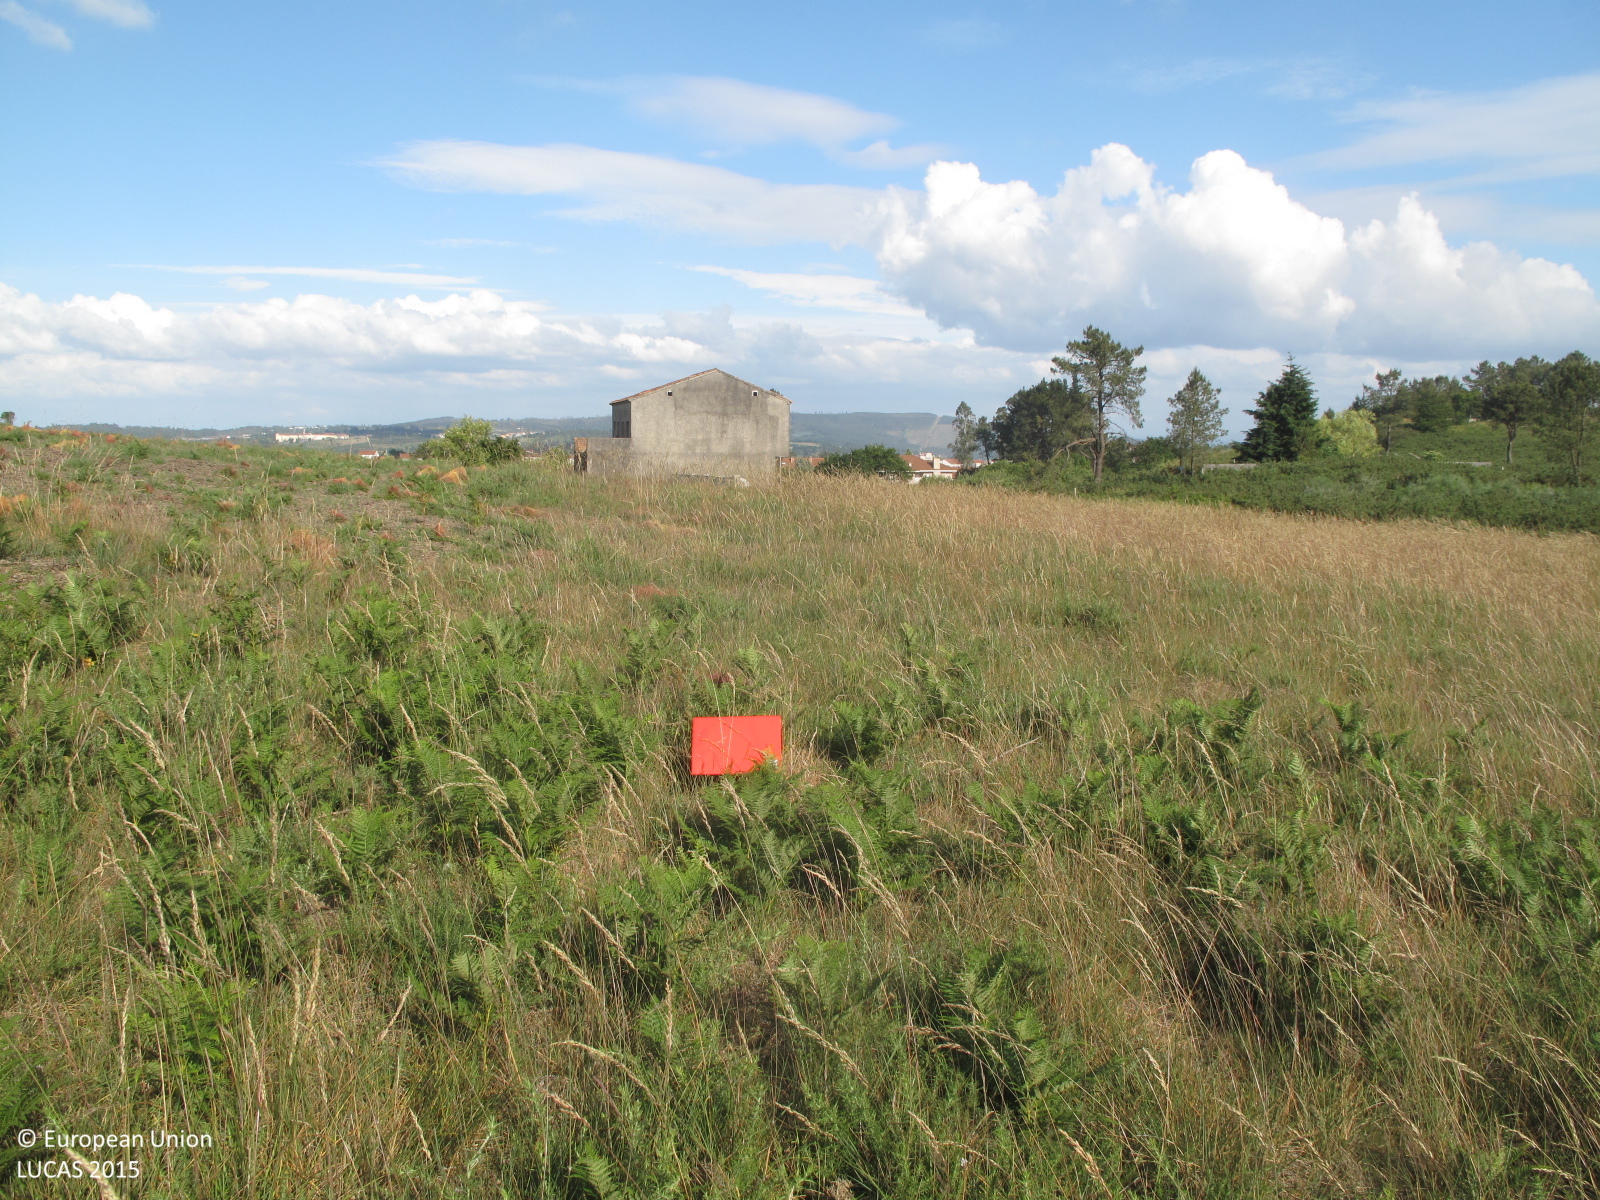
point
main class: Shrubland
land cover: Shrubland without tree cover
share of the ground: 10 - 25 %
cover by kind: herbaceous plants 90 %, shrubs 10 %
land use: Abandoned areas
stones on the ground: < 10 %
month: June
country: ES
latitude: 42.9023
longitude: -8.5371
